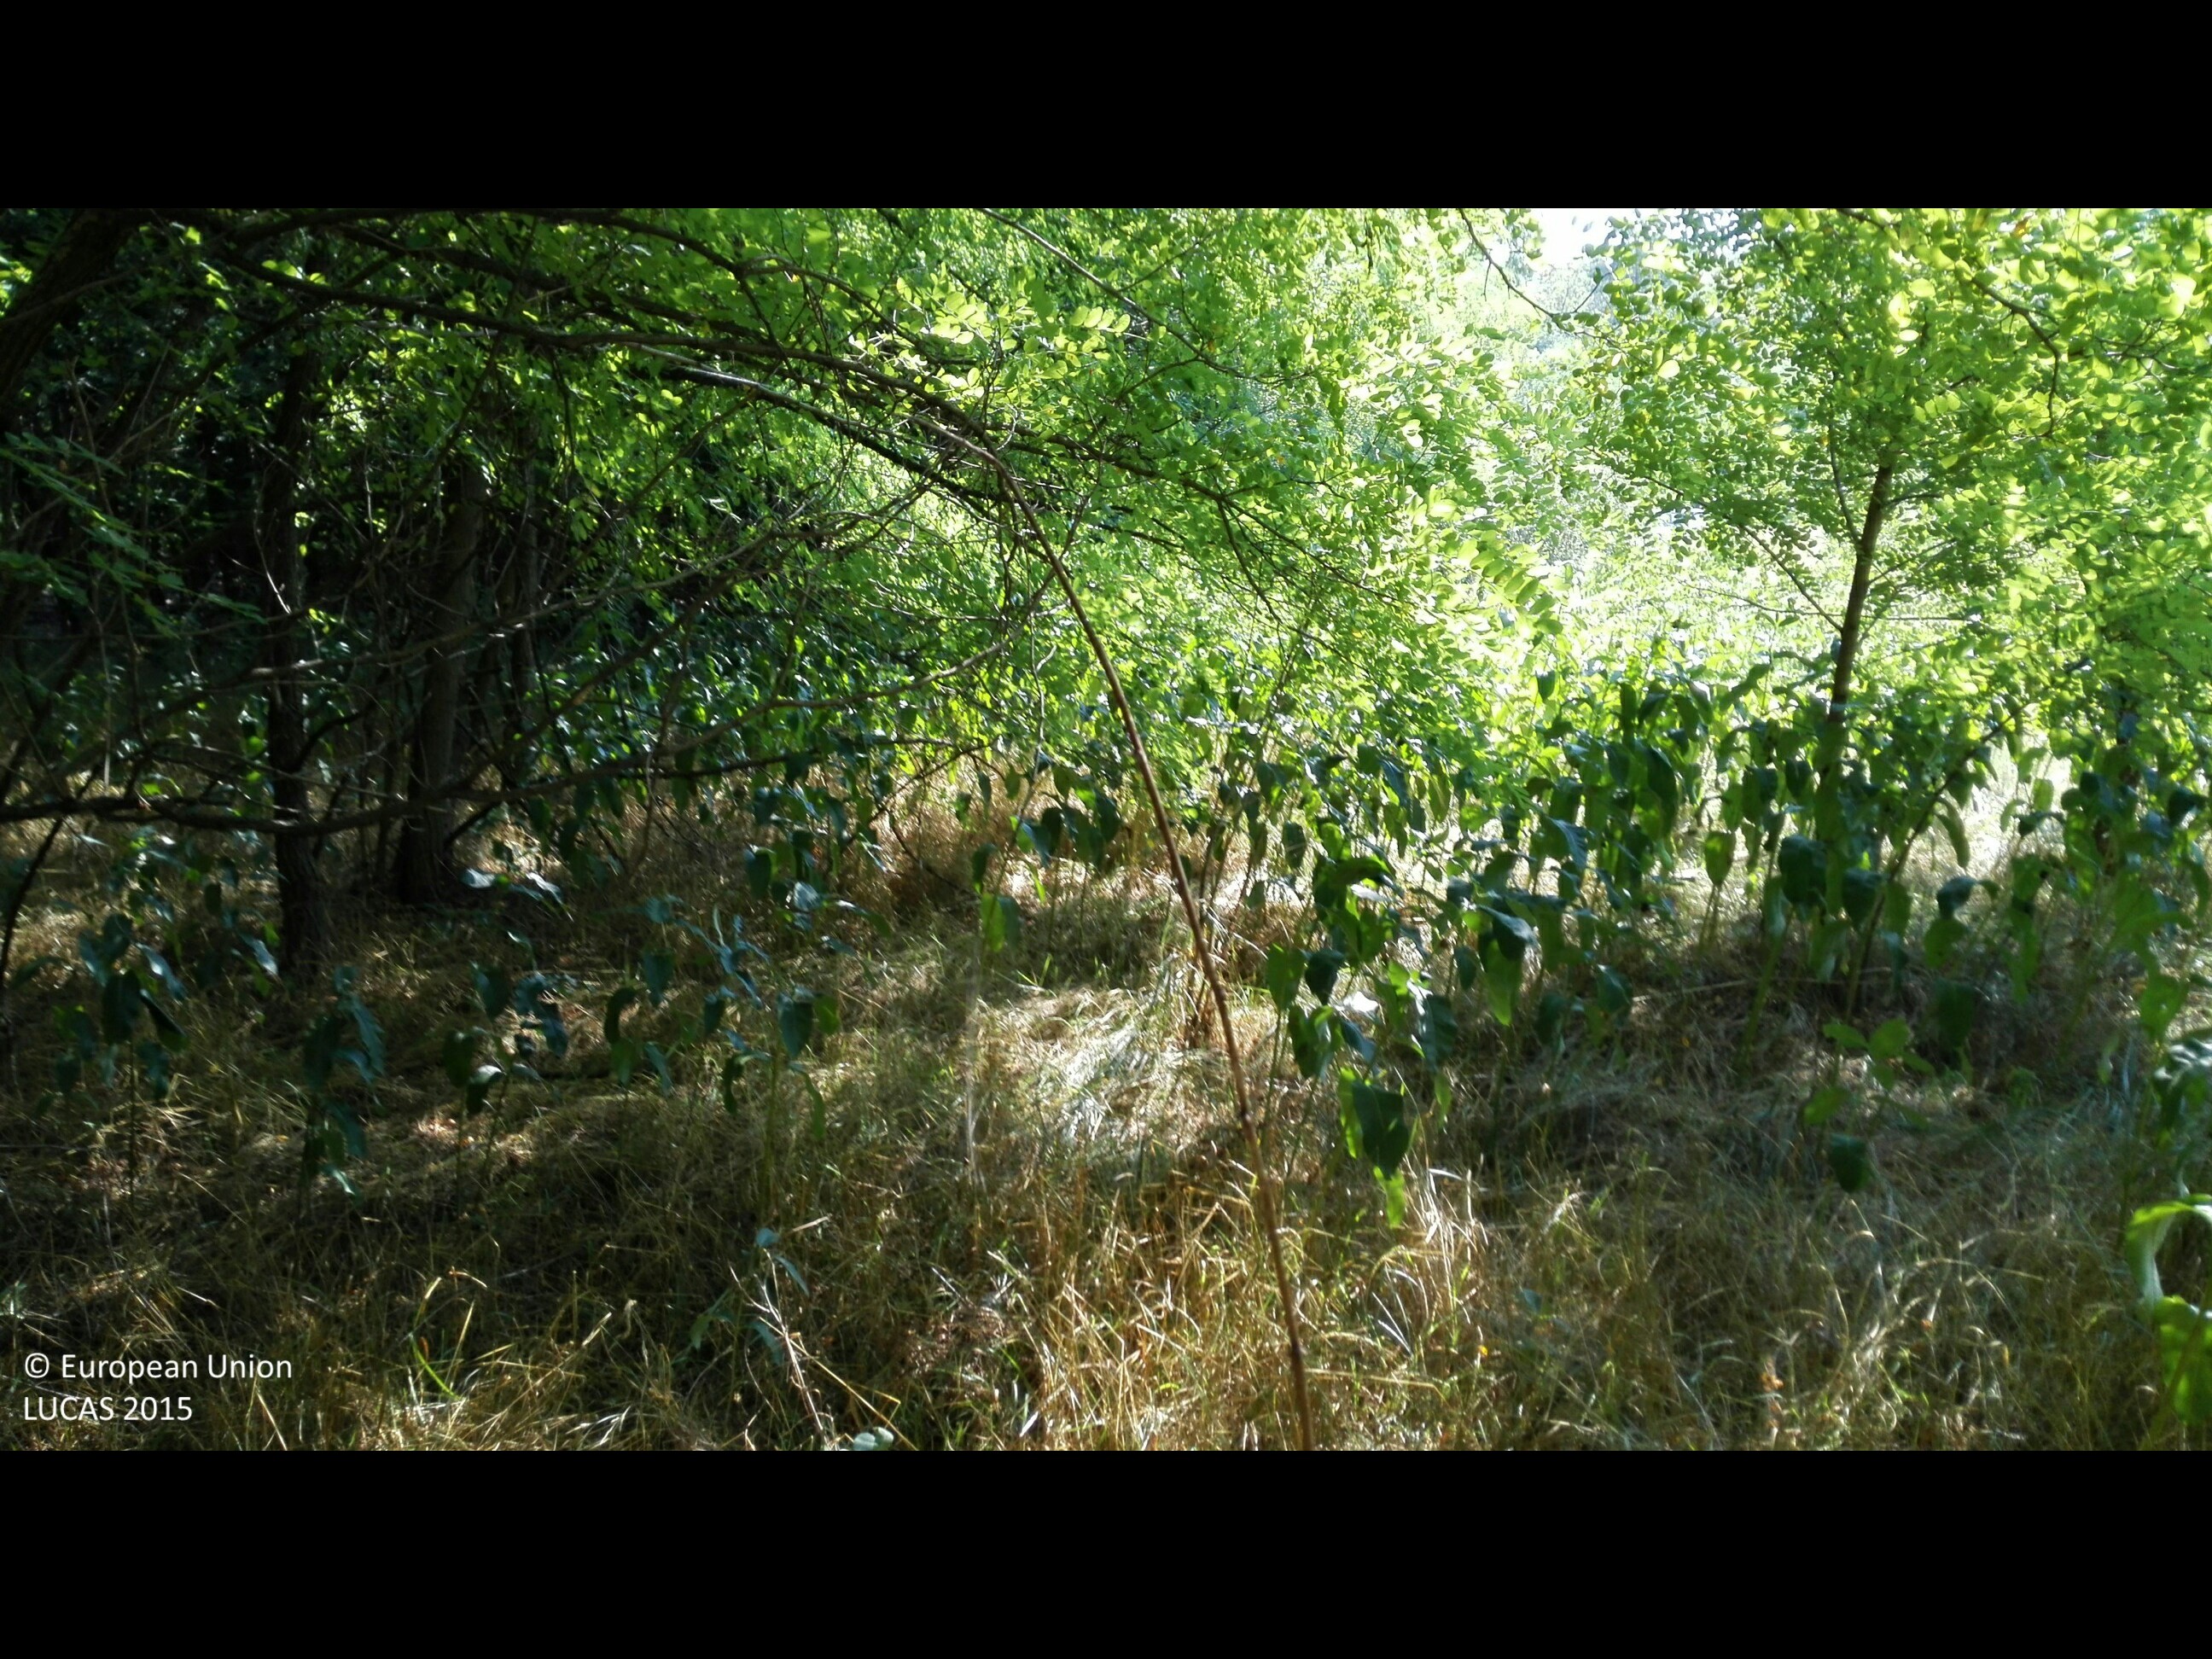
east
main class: Woodland
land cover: Broadleaved woodland
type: exotic forest
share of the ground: > 75 %
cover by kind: broadleaved forest trees 90 %, coniferous forest trees 5 %, herbaceous plants 5 %
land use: Forestry
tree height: > 5 m
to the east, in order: Broadleaved woodland; Tracks; Broadleaved woodland
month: August
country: HU
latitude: 47.6334
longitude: 22.0421
